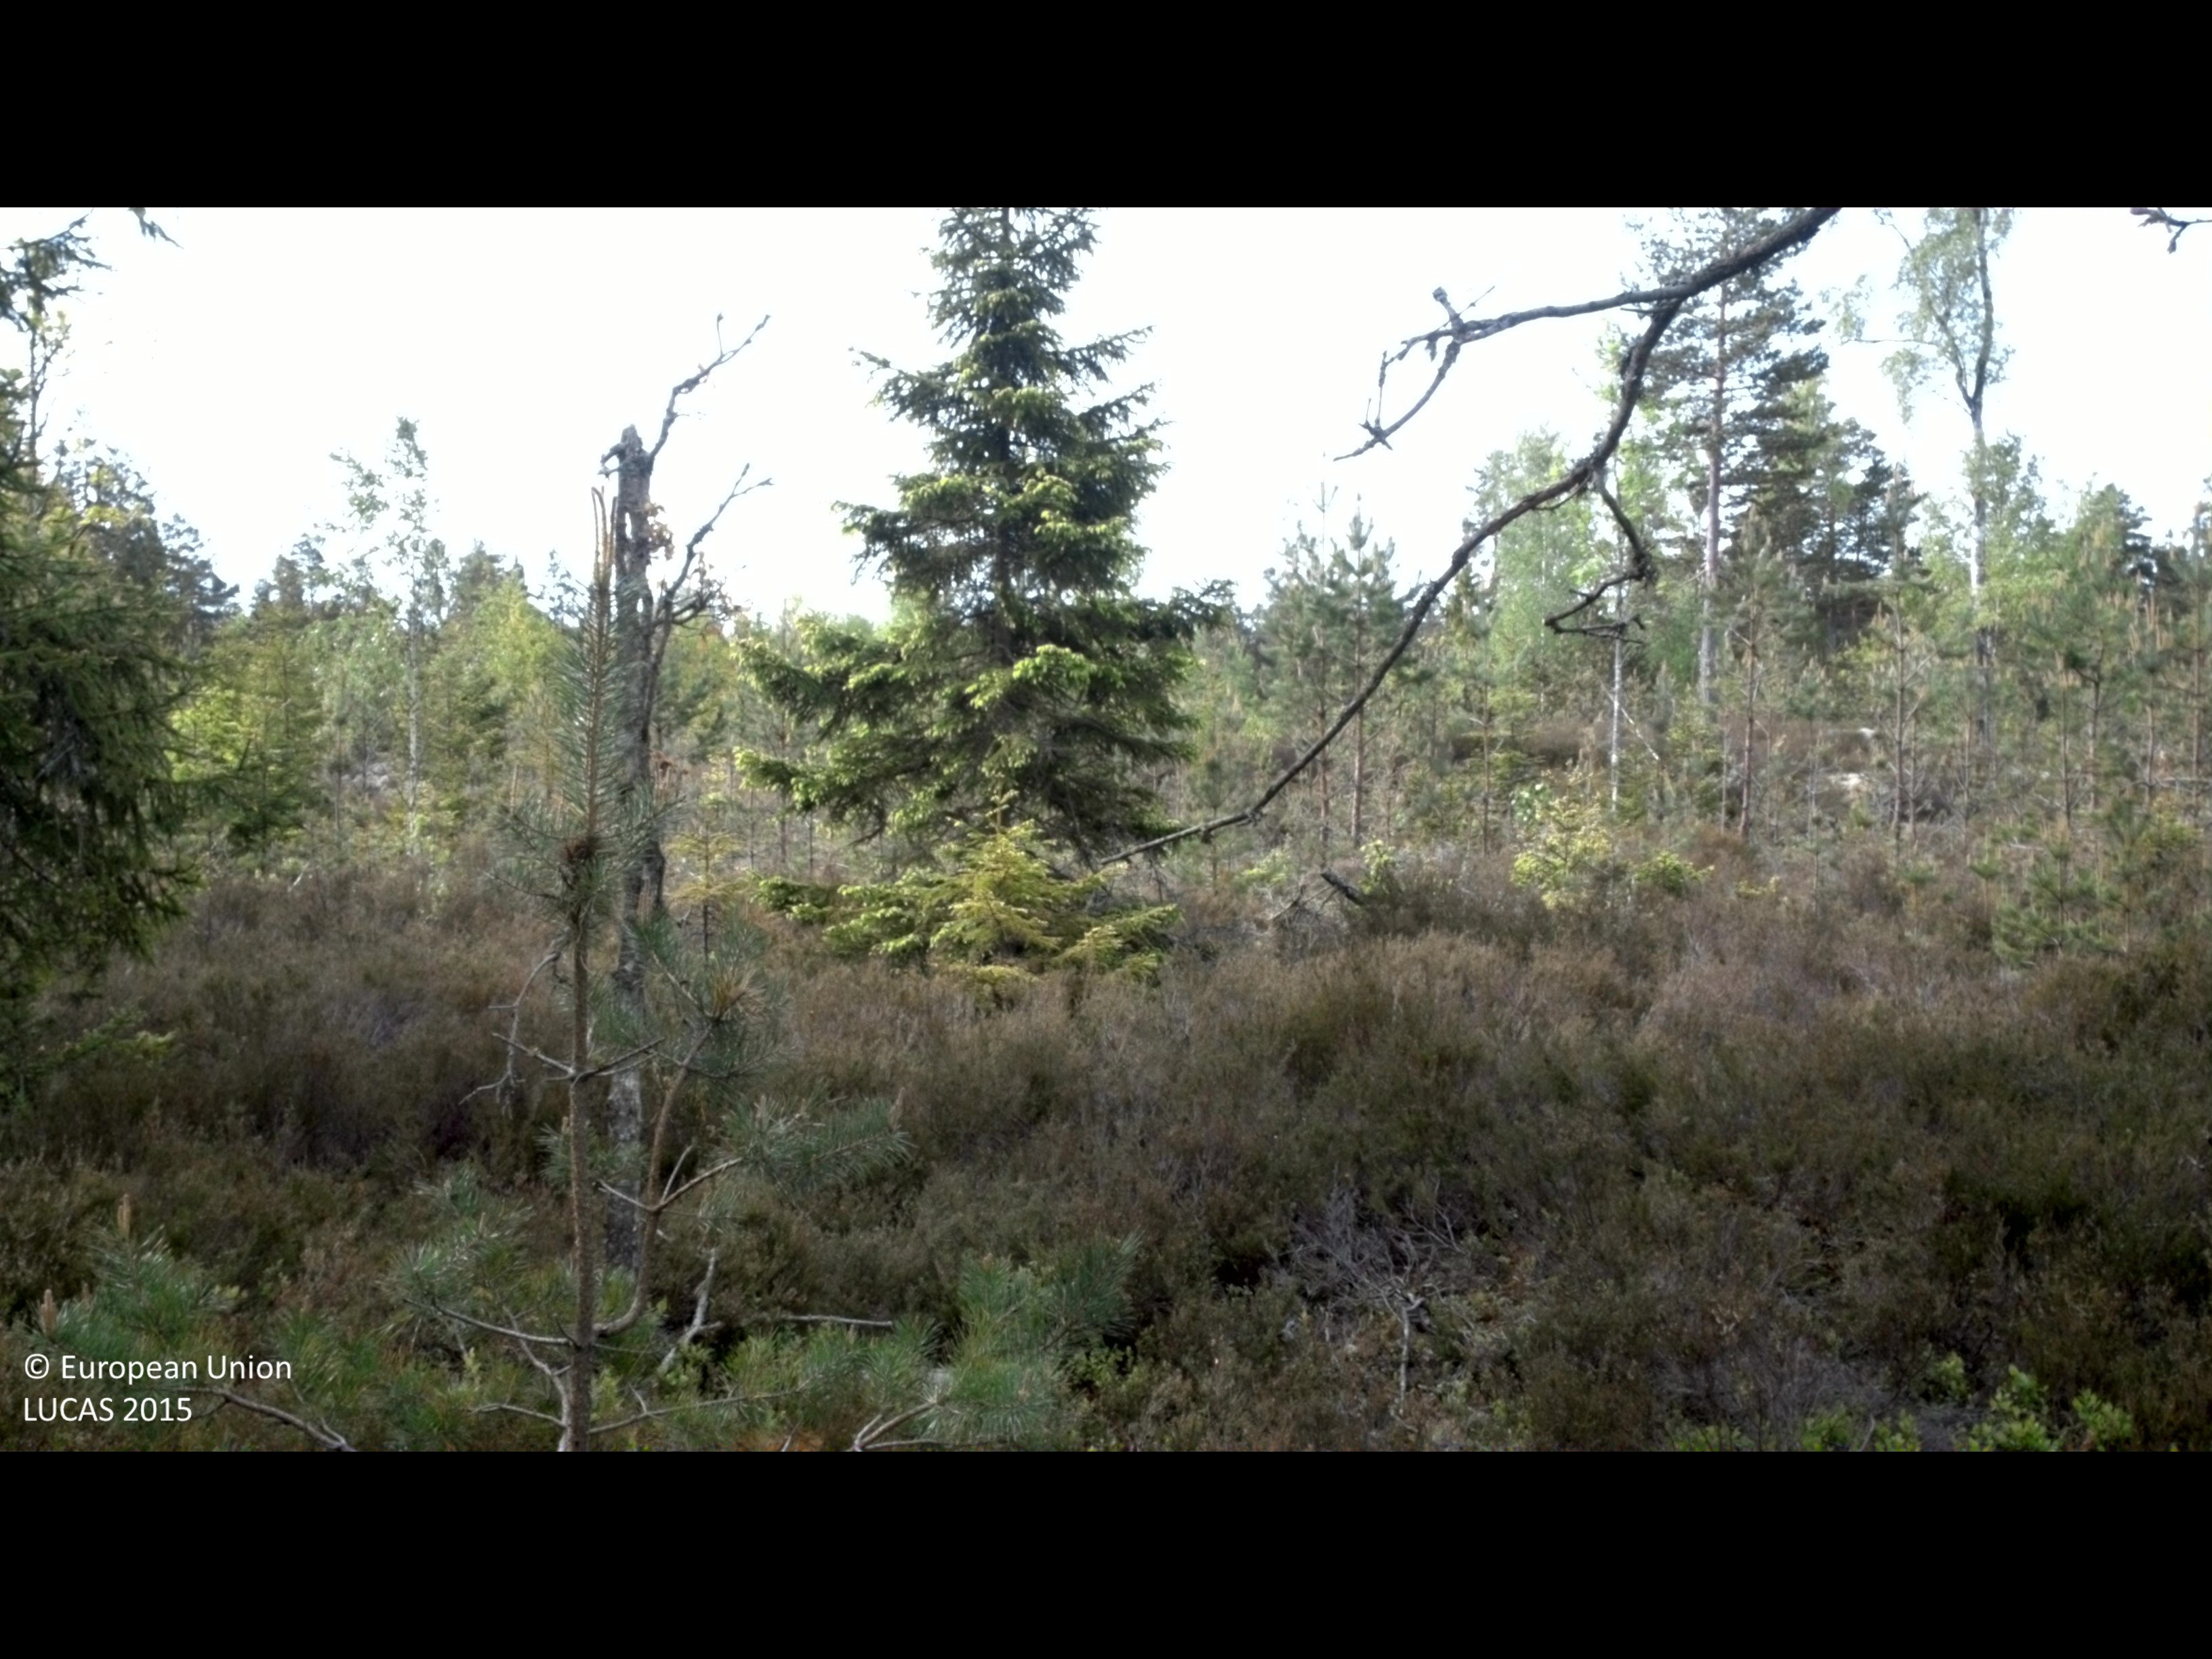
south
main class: Woodland
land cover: Pine dominated mixed woodland
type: boreal forest
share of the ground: > 75 %
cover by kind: coniferous forest trees 60 %, broadleaved forest trees 25 %, shrubs 15 %
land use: Forestry
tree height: > 5 m
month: May
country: SE
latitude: 57.3242
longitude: 16.4598
